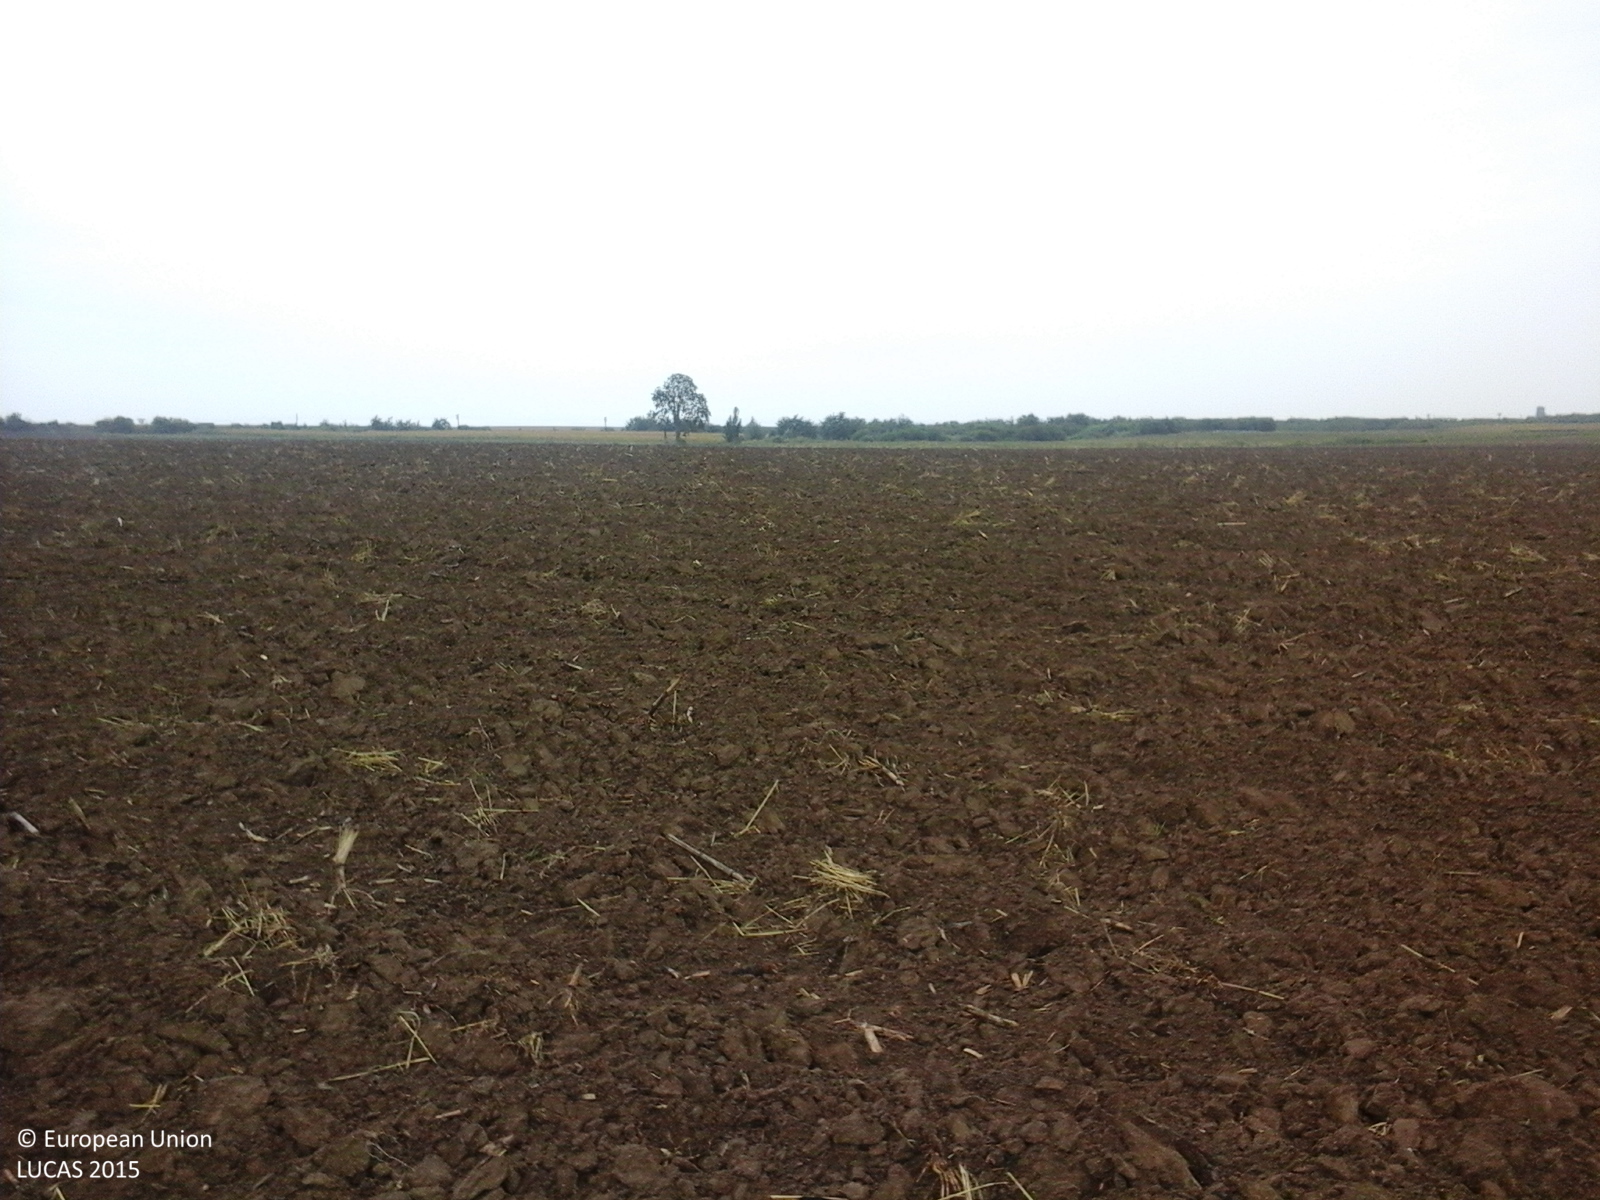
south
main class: Cropland
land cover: Common wheat
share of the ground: < 10 %
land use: Agriculture (excluding fallow land and kitchen gardens)
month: September
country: RO
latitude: 47.6216
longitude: 22.3094
